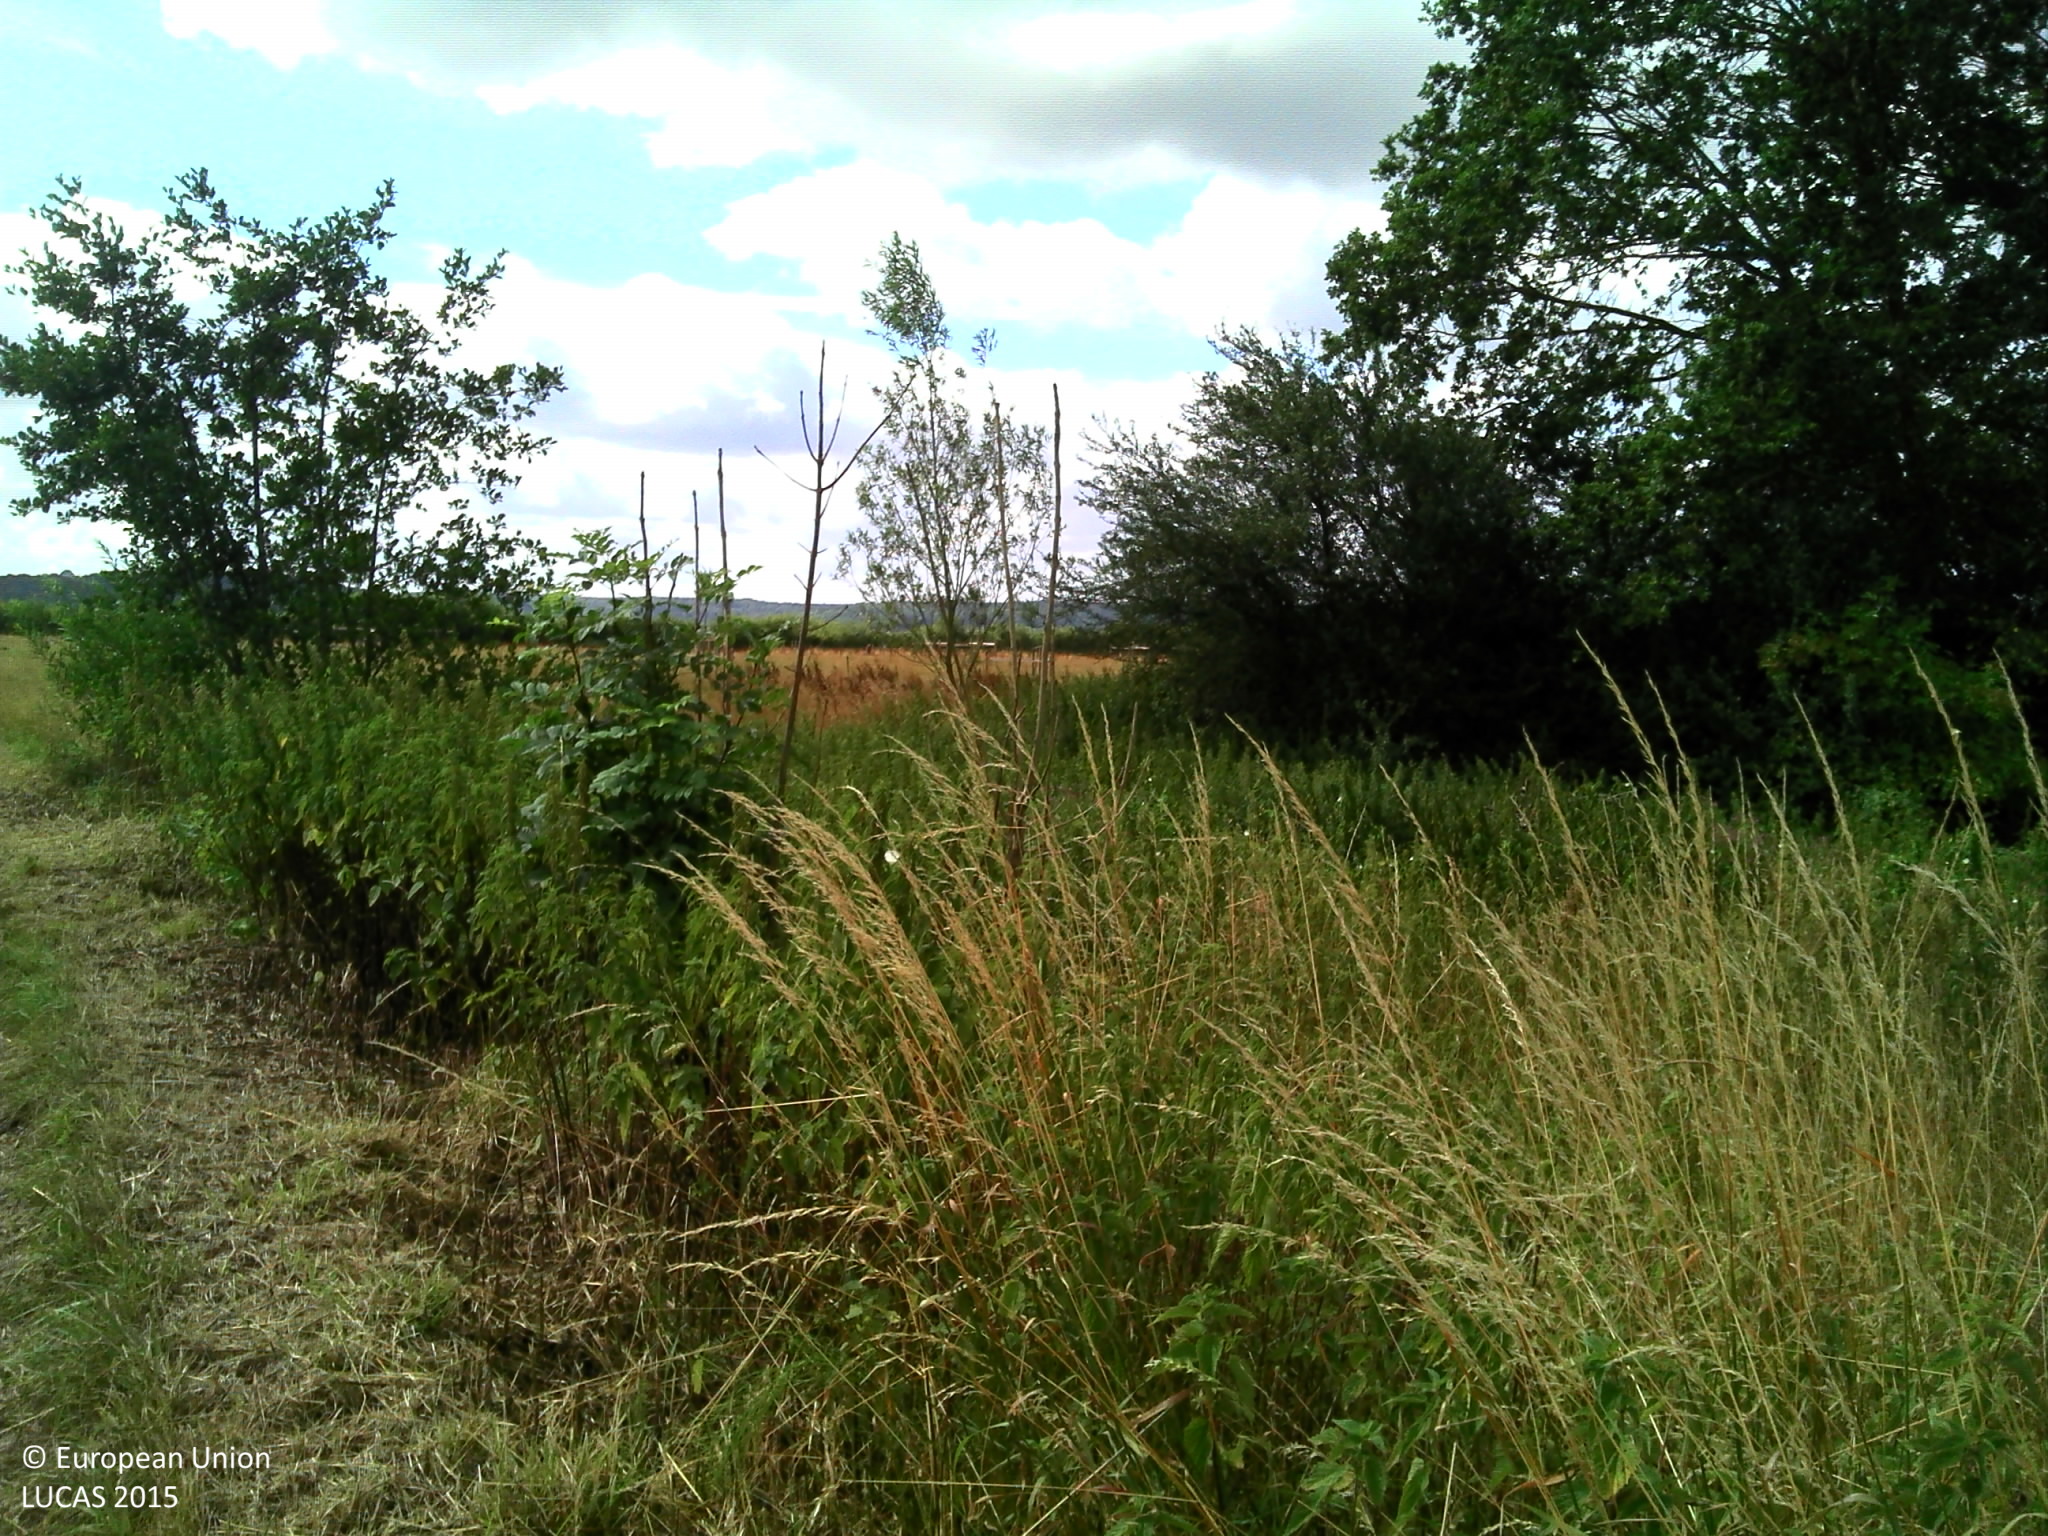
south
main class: Cropland
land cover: Temporary grasslands
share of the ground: > 75 %
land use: Agriculture (excluding fallow land and kitchen gardens)
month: July
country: BE
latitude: 49.5860
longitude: 5.8355
